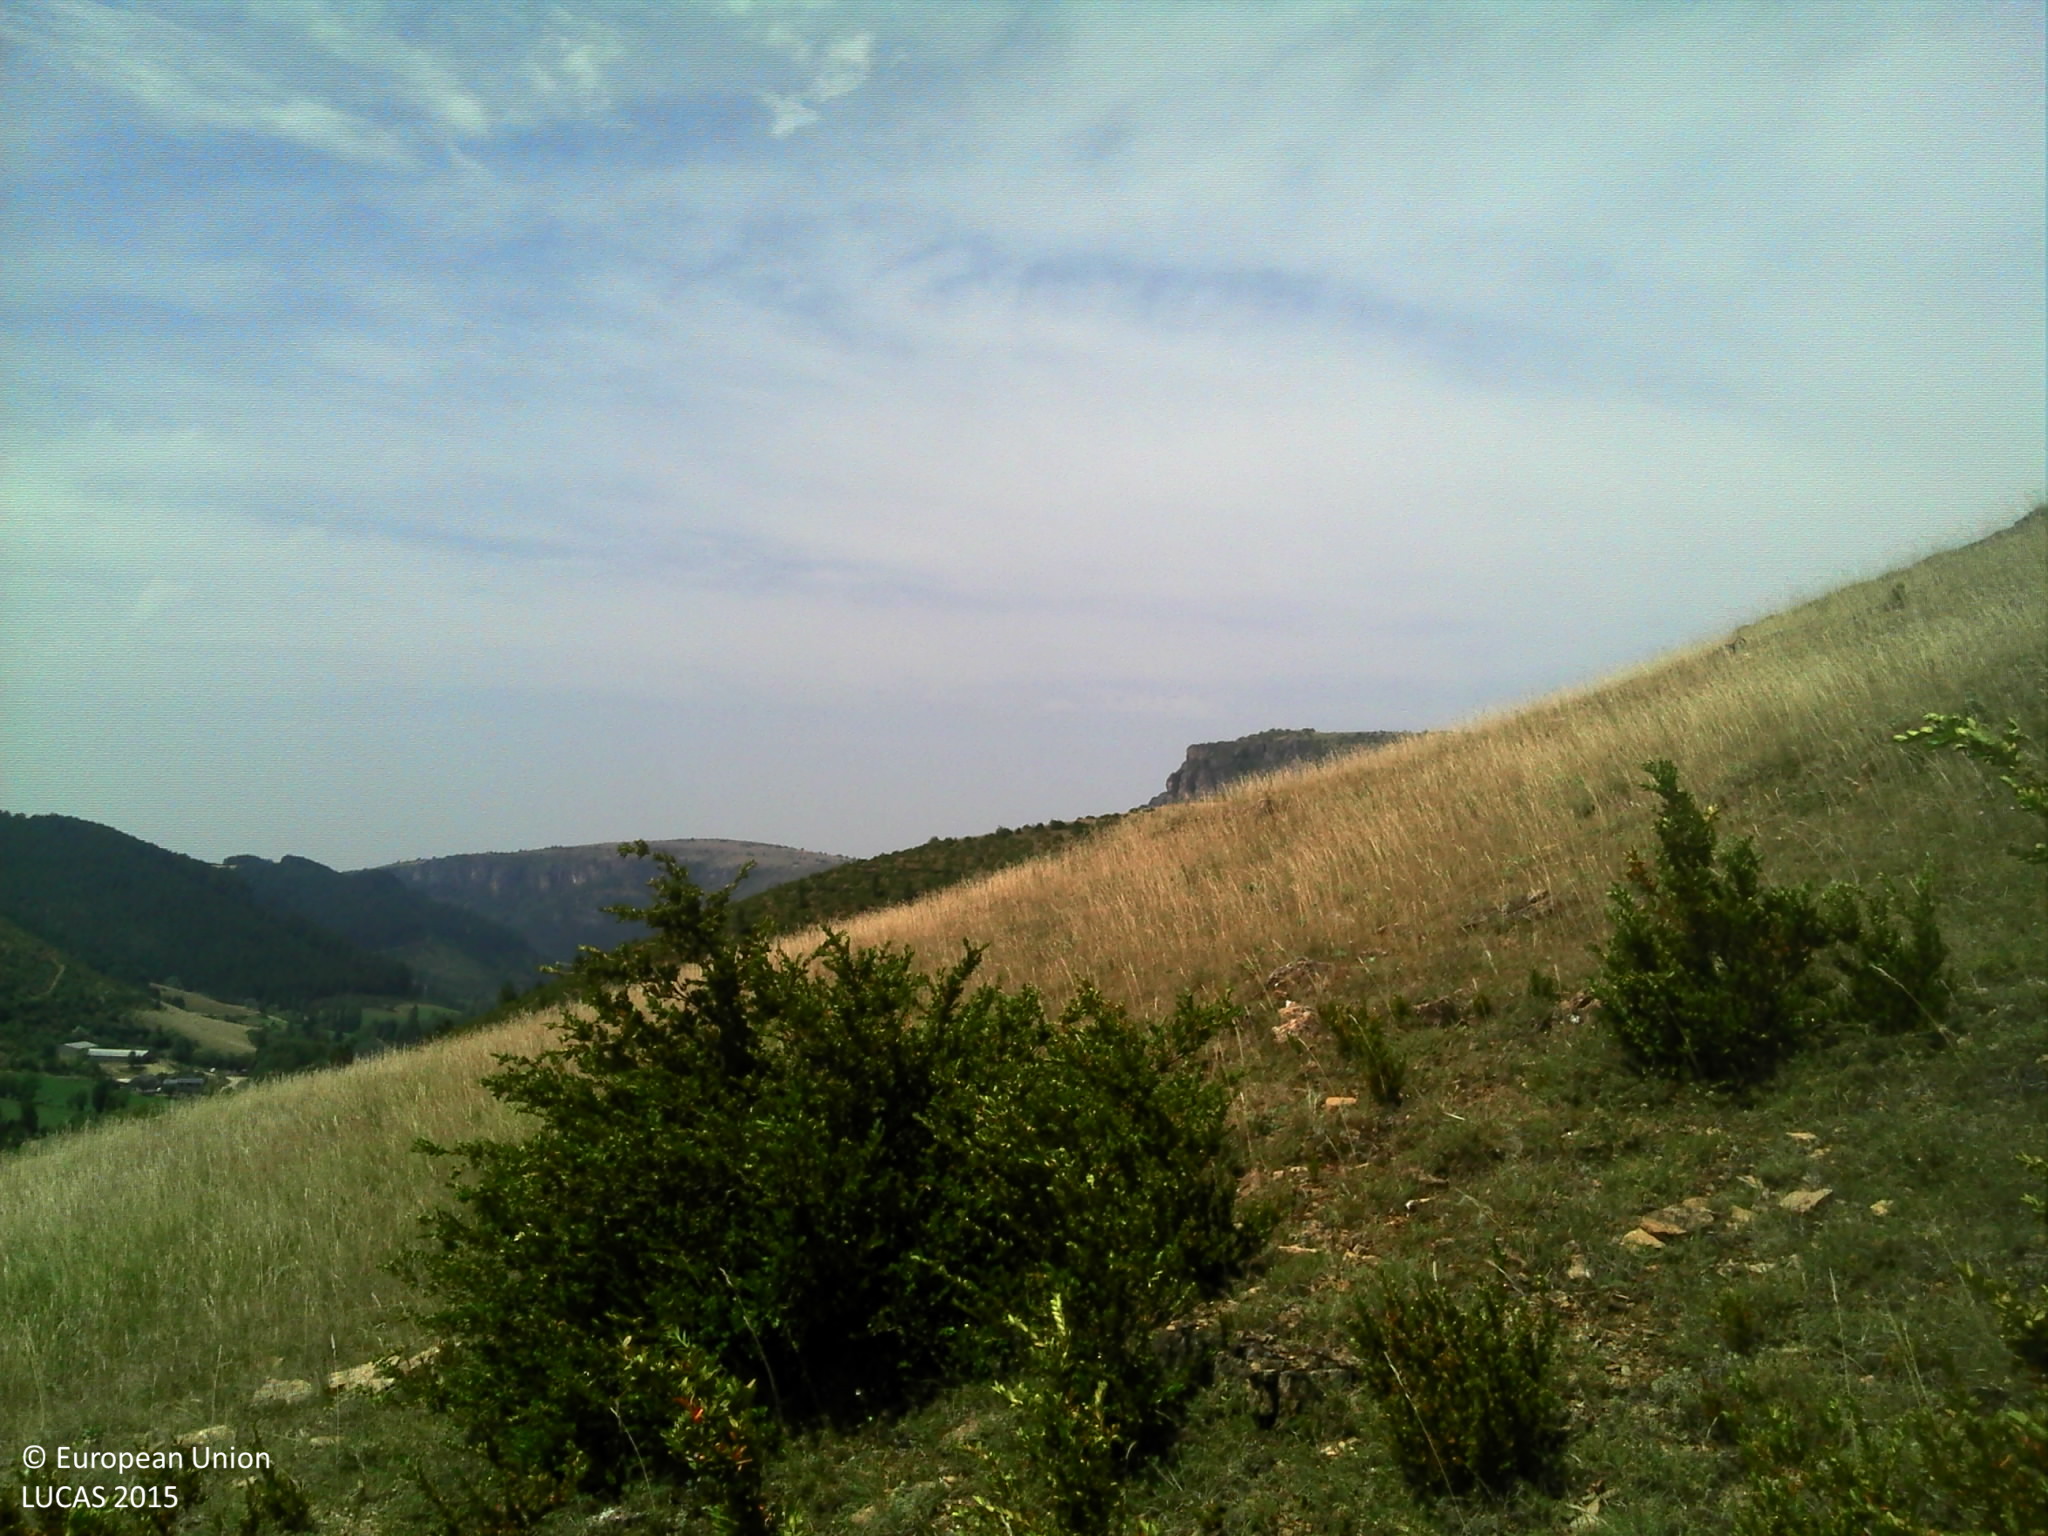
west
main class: Shrubland
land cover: Shrubland without tree cover
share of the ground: > 75 %
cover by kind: herbaceous plants 55 %, shrubs 45 %
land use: Agriculture (excluding fallow land and kitchen gardens)
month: July
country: FR
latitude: 44.2002
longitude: 3.4871
